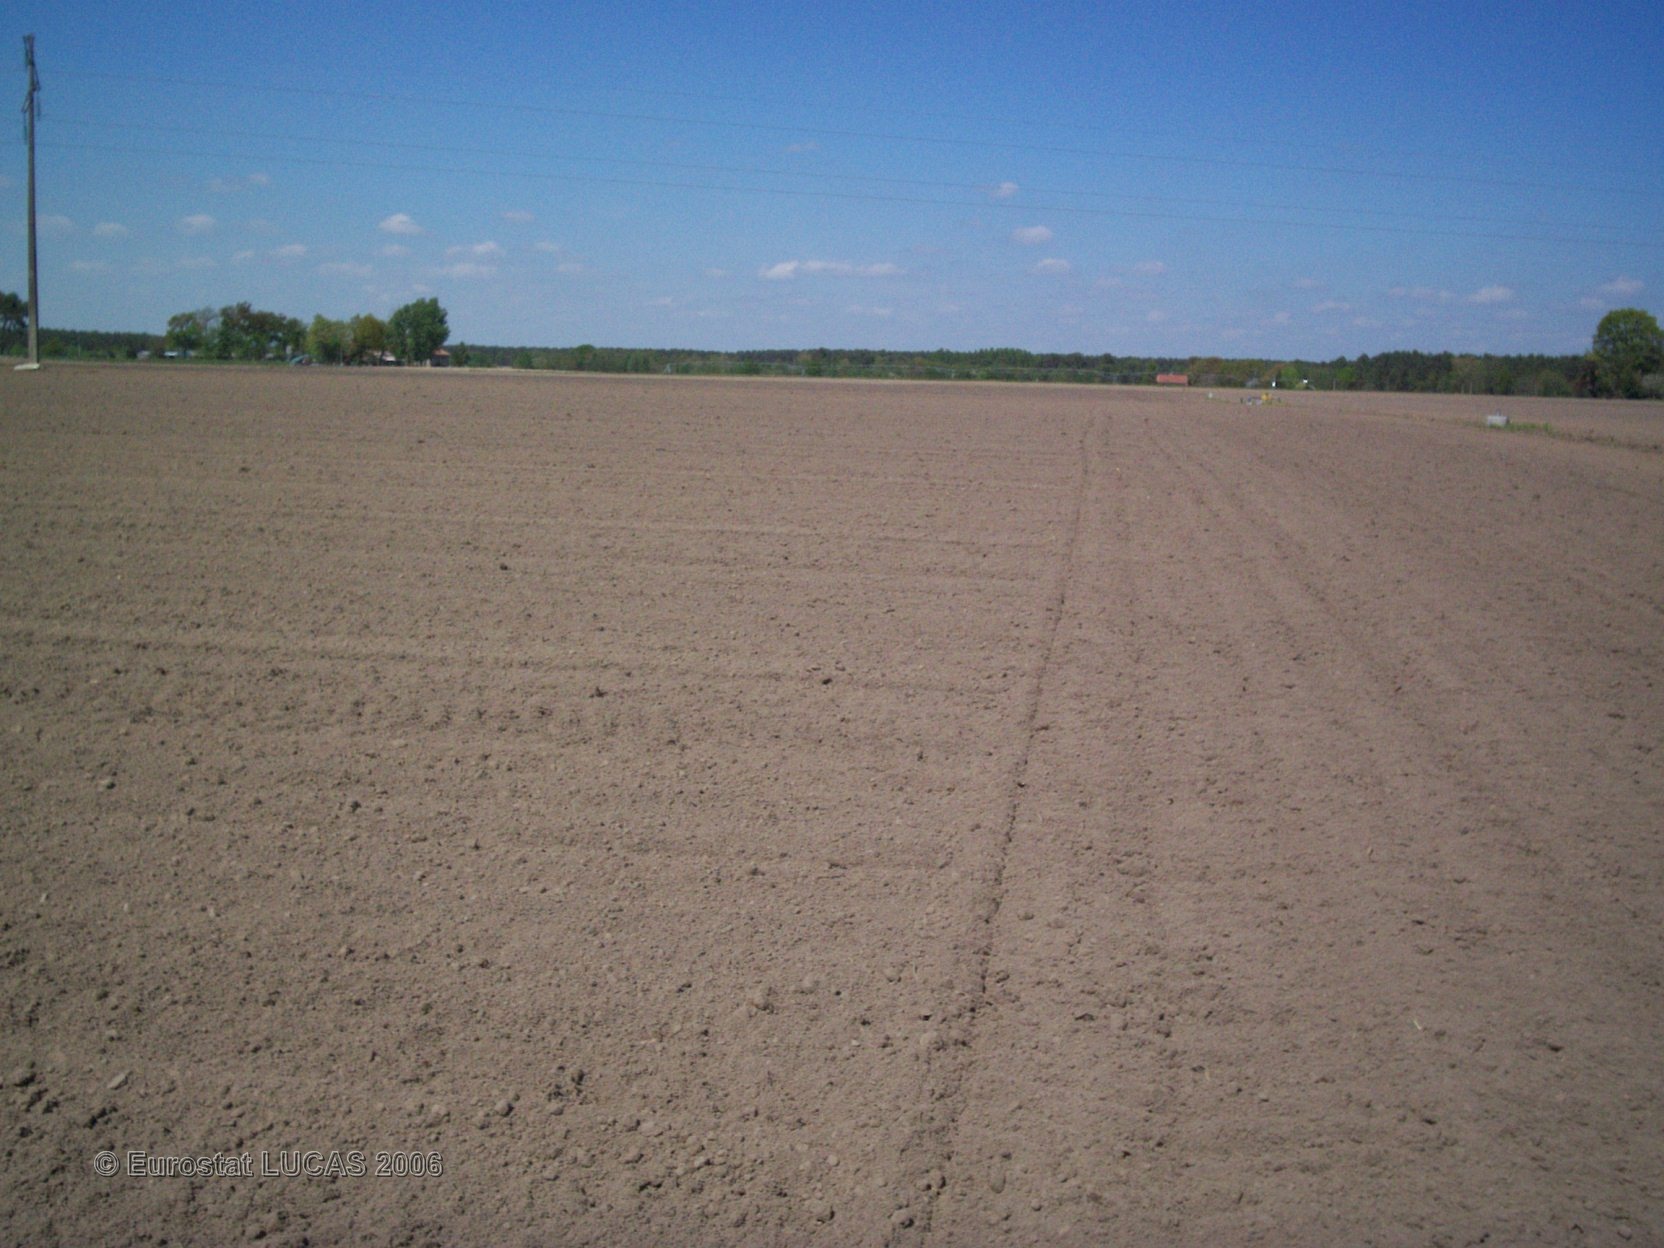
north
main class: Cropland
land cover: Maize
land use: Agriculture (excluding fallow land and kitchen gardens)
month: June
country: FR
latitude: 43.8300
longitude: -0.7203
